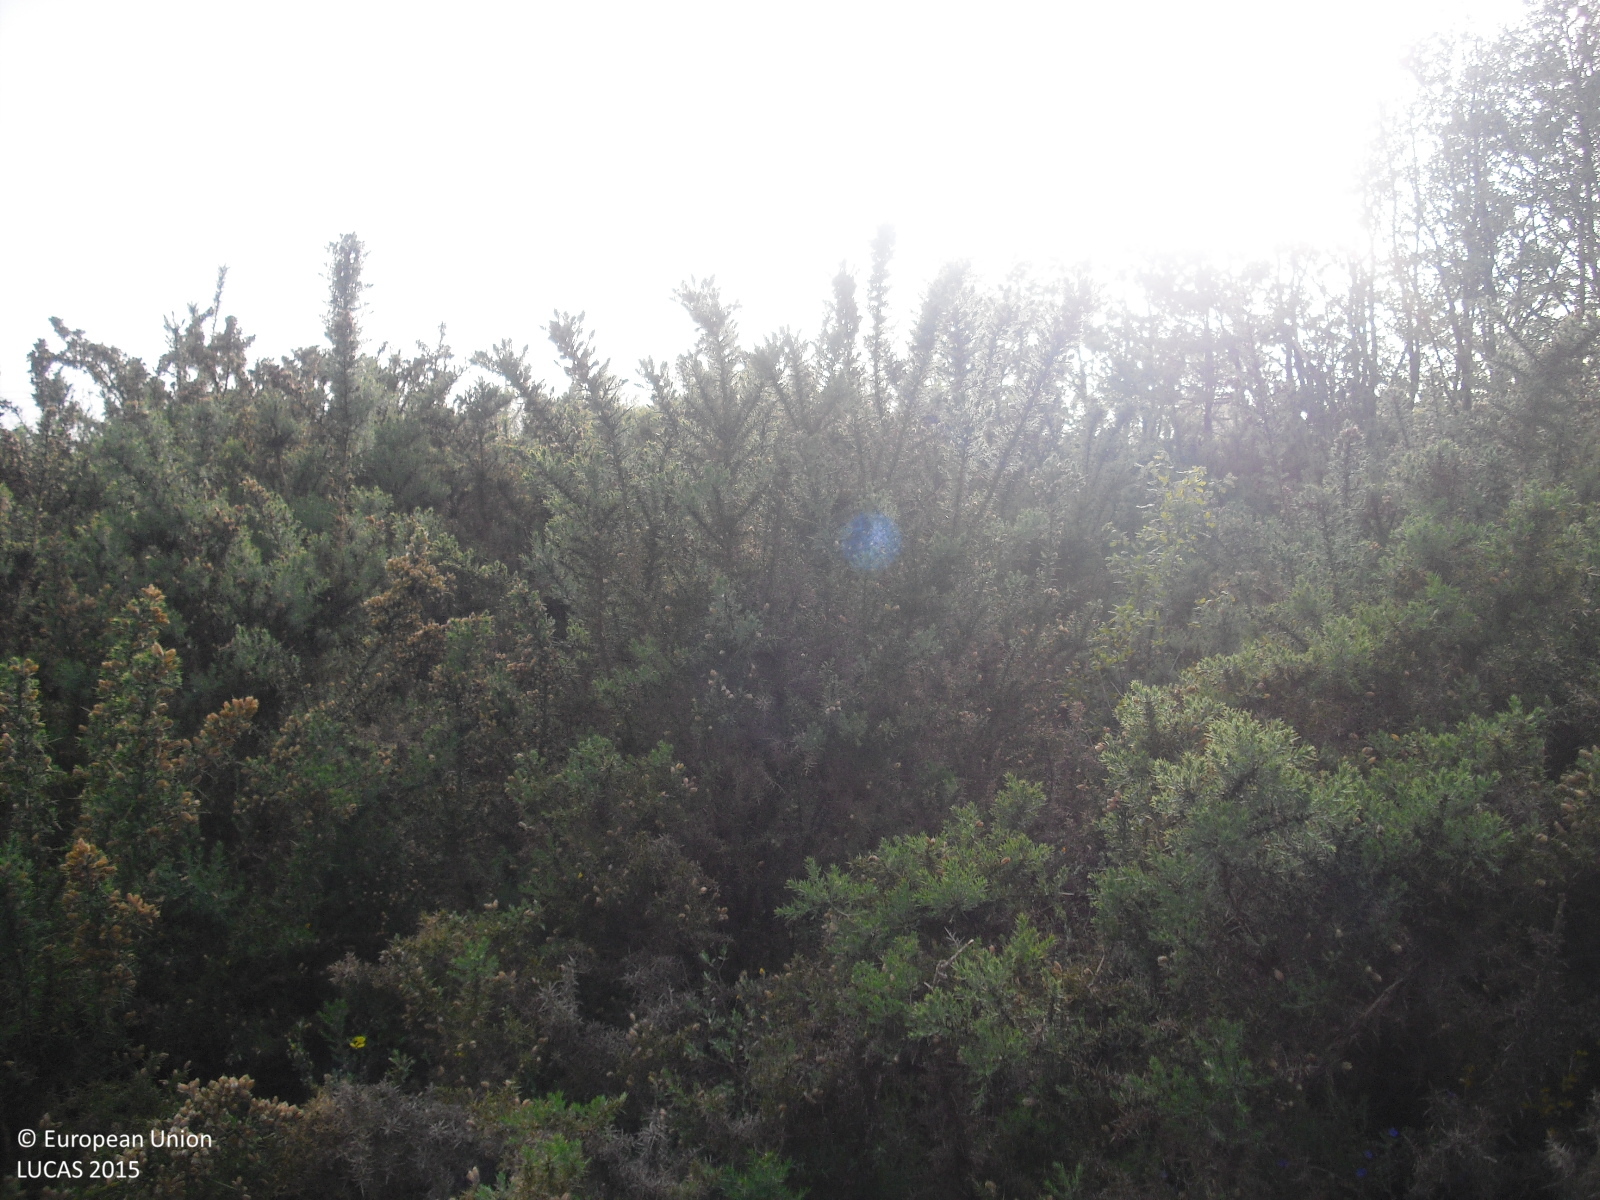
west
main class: Shrubland
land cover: Shrubland with sparse tree cover
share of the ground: > 75 %
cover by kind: shrubs 95 %, broadleaved forest trees 5 %
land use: Semi-natural and natural areas not in use
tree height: < 5 m
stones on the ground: 10 - 25 %
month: May
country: ES
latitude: 42.1668
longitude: -7.6070
